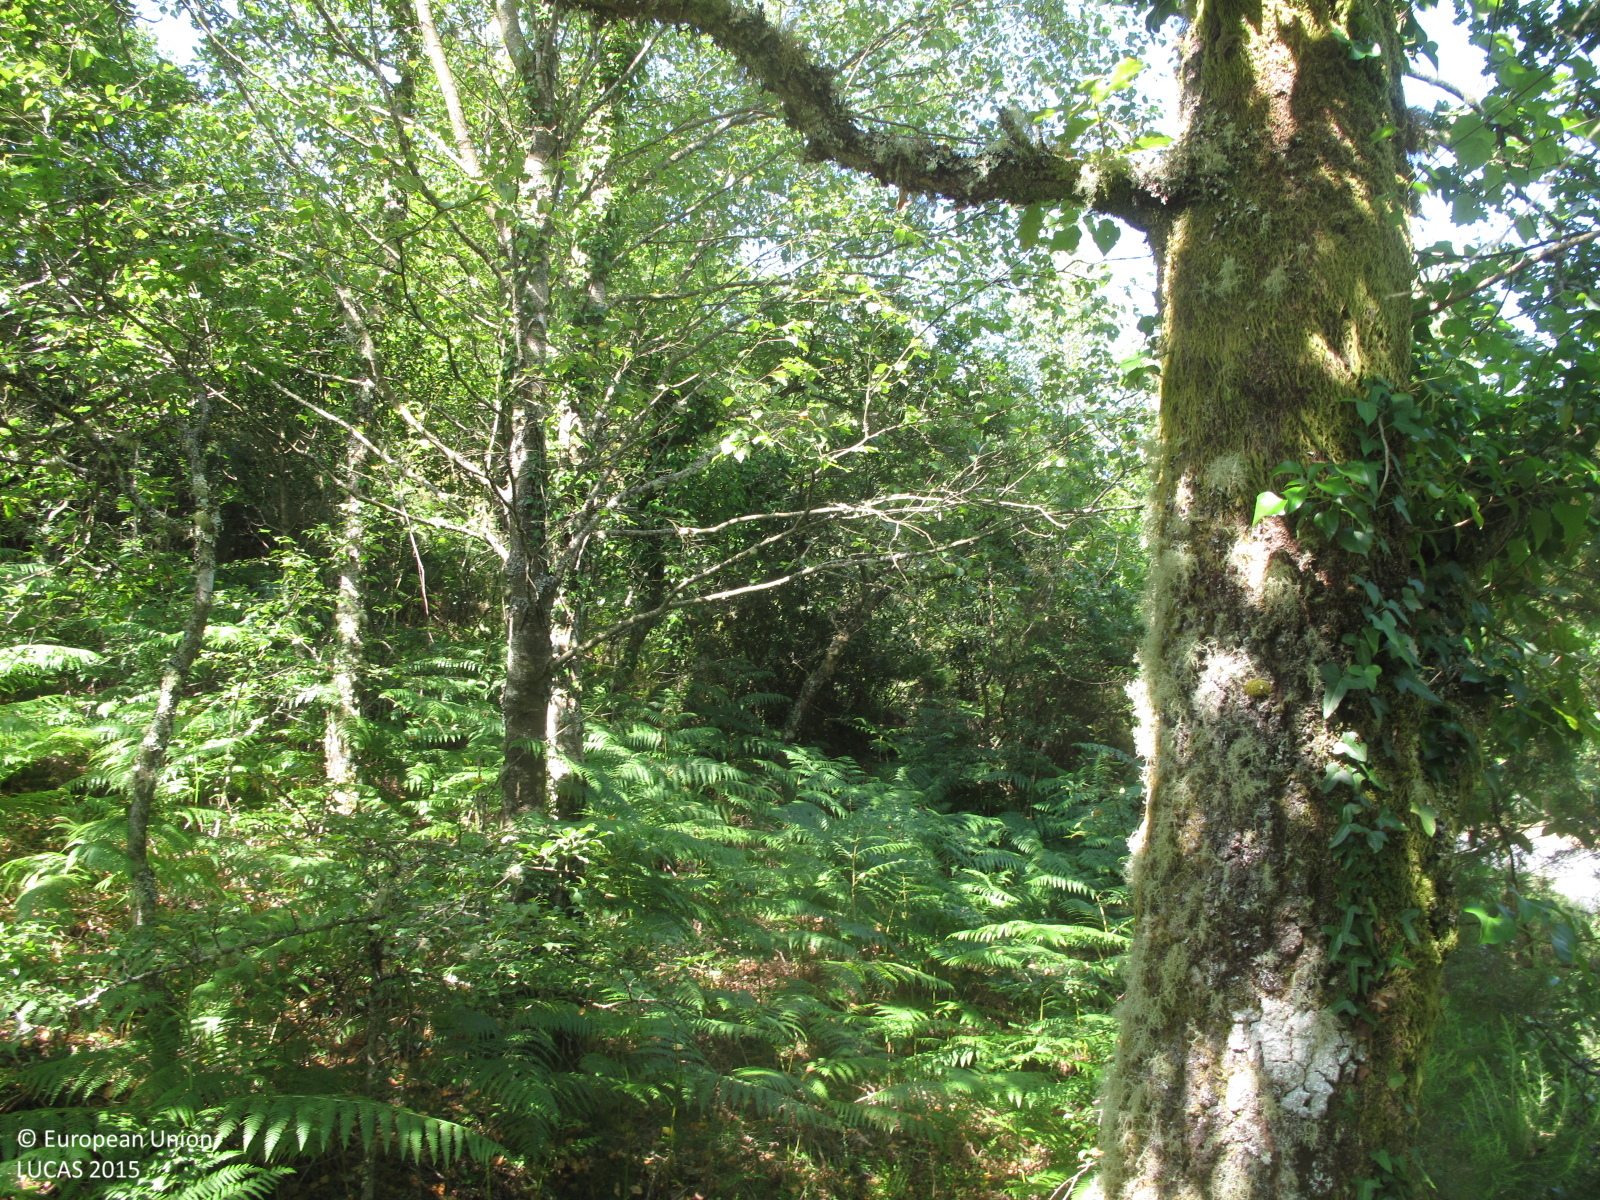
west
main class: Woodland
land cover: Broadleaved woodland
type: acidophilous oak and oak-birch forest
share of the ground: 50 - 75 %
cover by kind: broadleaved forest trees 60 %, shrubs 30 %, herbaceous plants 10 %
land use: Semi-natural and natural areas not in use
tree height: > 5 m
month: July
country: ES
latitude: 43.3341
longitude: -7.9900
